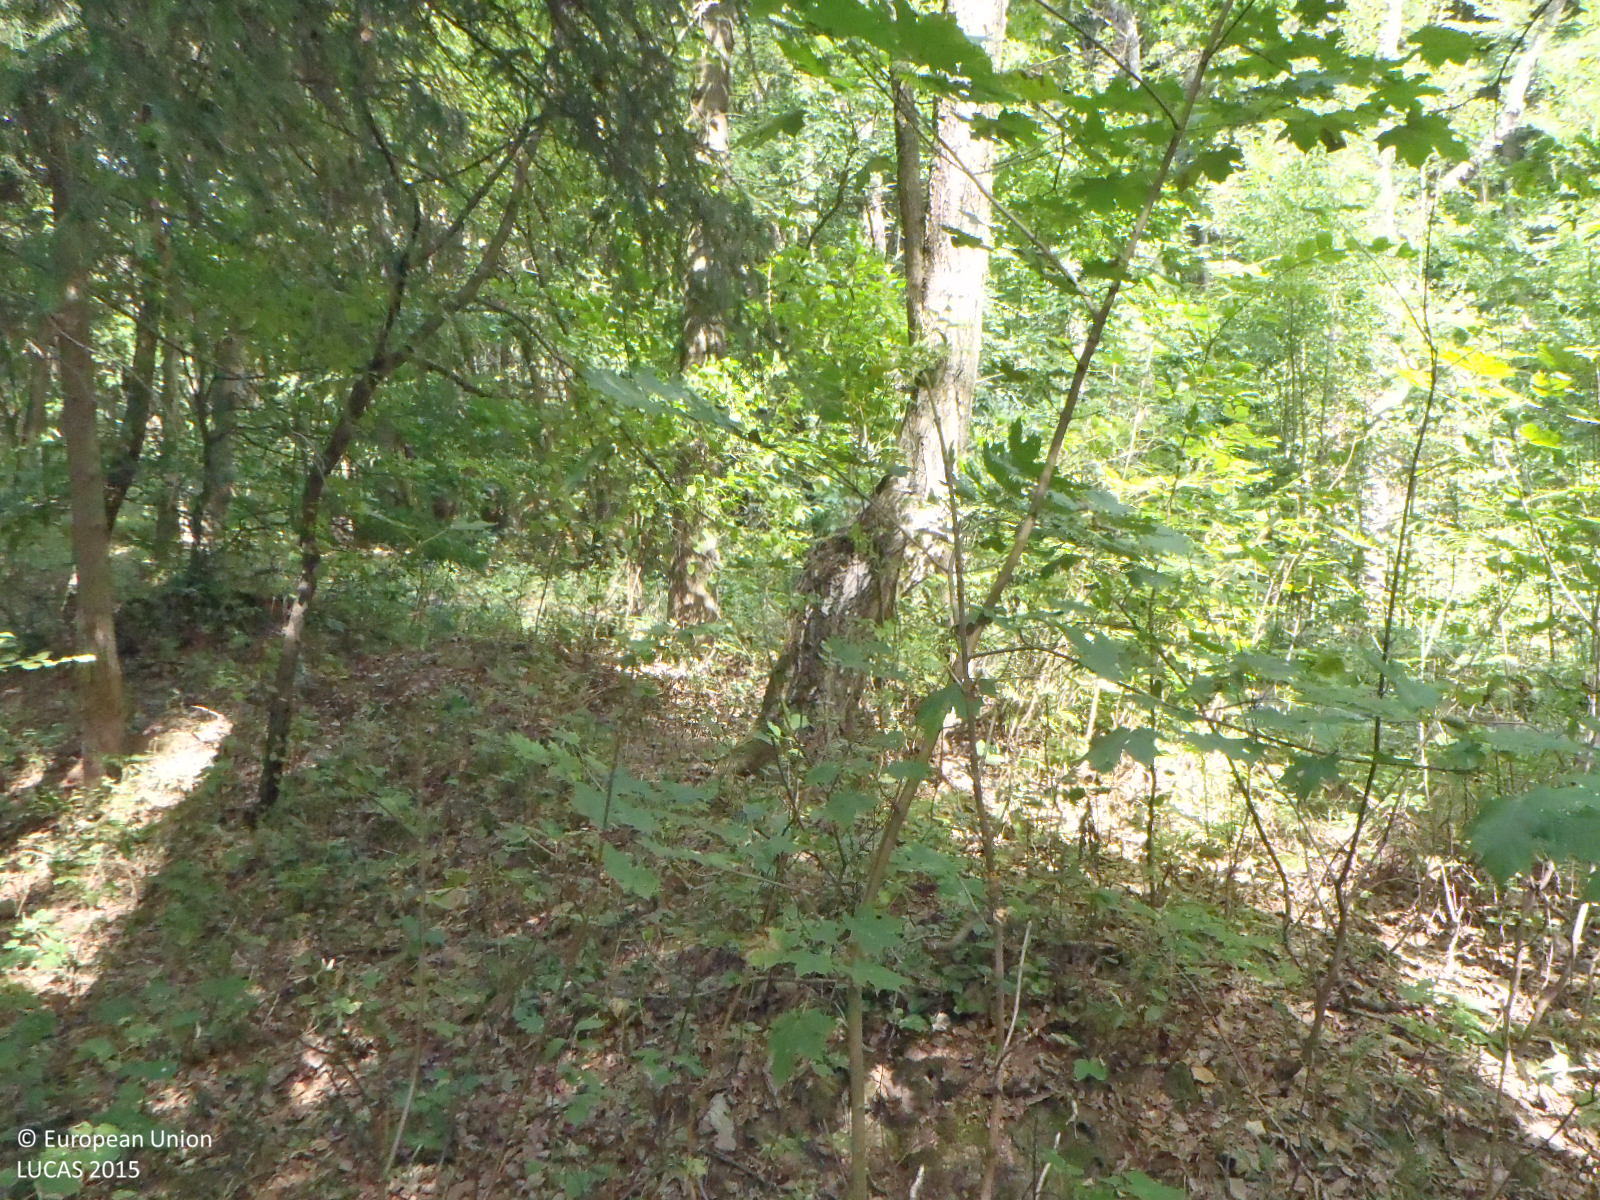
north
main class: Woodland
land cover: Spruce dominated mixed woodland
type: hemiboreal forest and nemoral coniferous forest and mixed broadleaved-coniferous forest
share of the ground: > 75 %
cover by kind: broadleaved forest trees 70 %, coniferous forest trees 30 %
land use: Forestry
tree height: > 5 m
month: September
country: CZ
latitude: 50.6938
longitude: 13.8939
